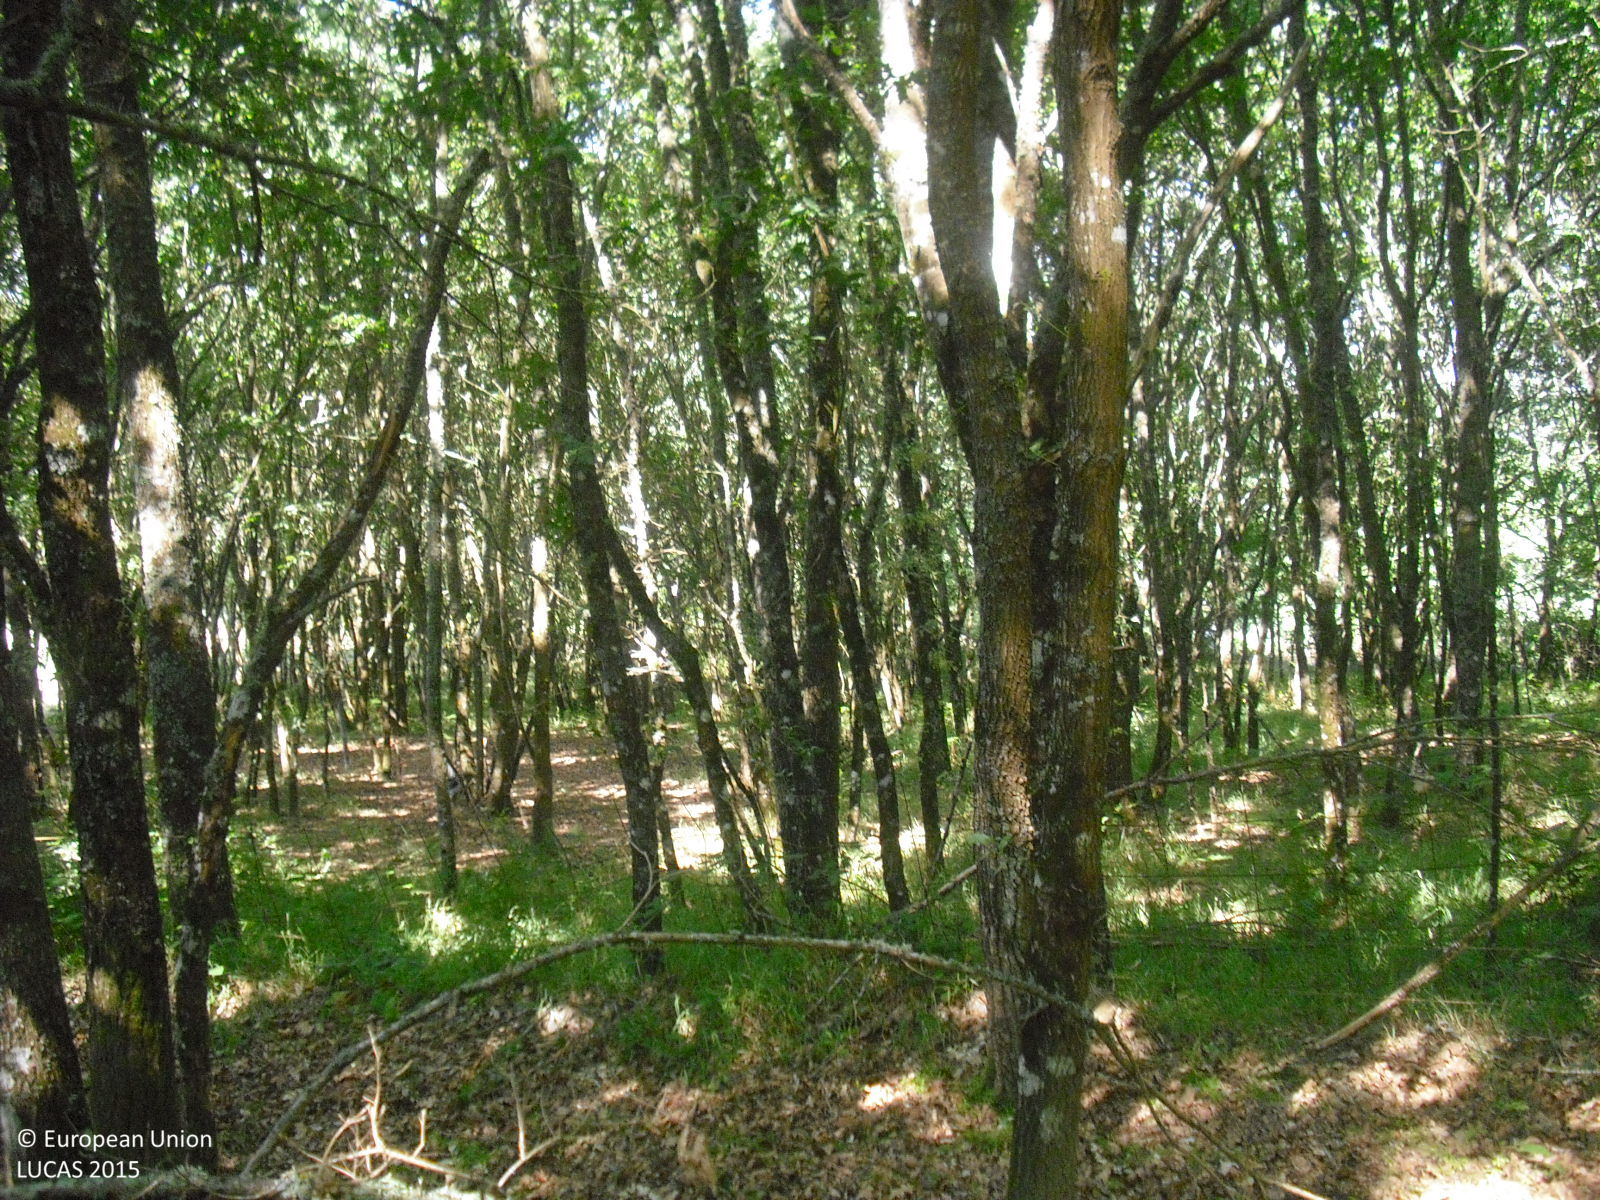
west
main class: Woodland
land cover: Broadleaved woodland
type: thermophilous deciduous forest
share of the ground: > 75 %
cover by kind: broadleaved forest trees 100 %
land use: Forestry
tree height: > 5 m
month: June
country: ES
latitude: 42.6043
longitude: -7.7387
